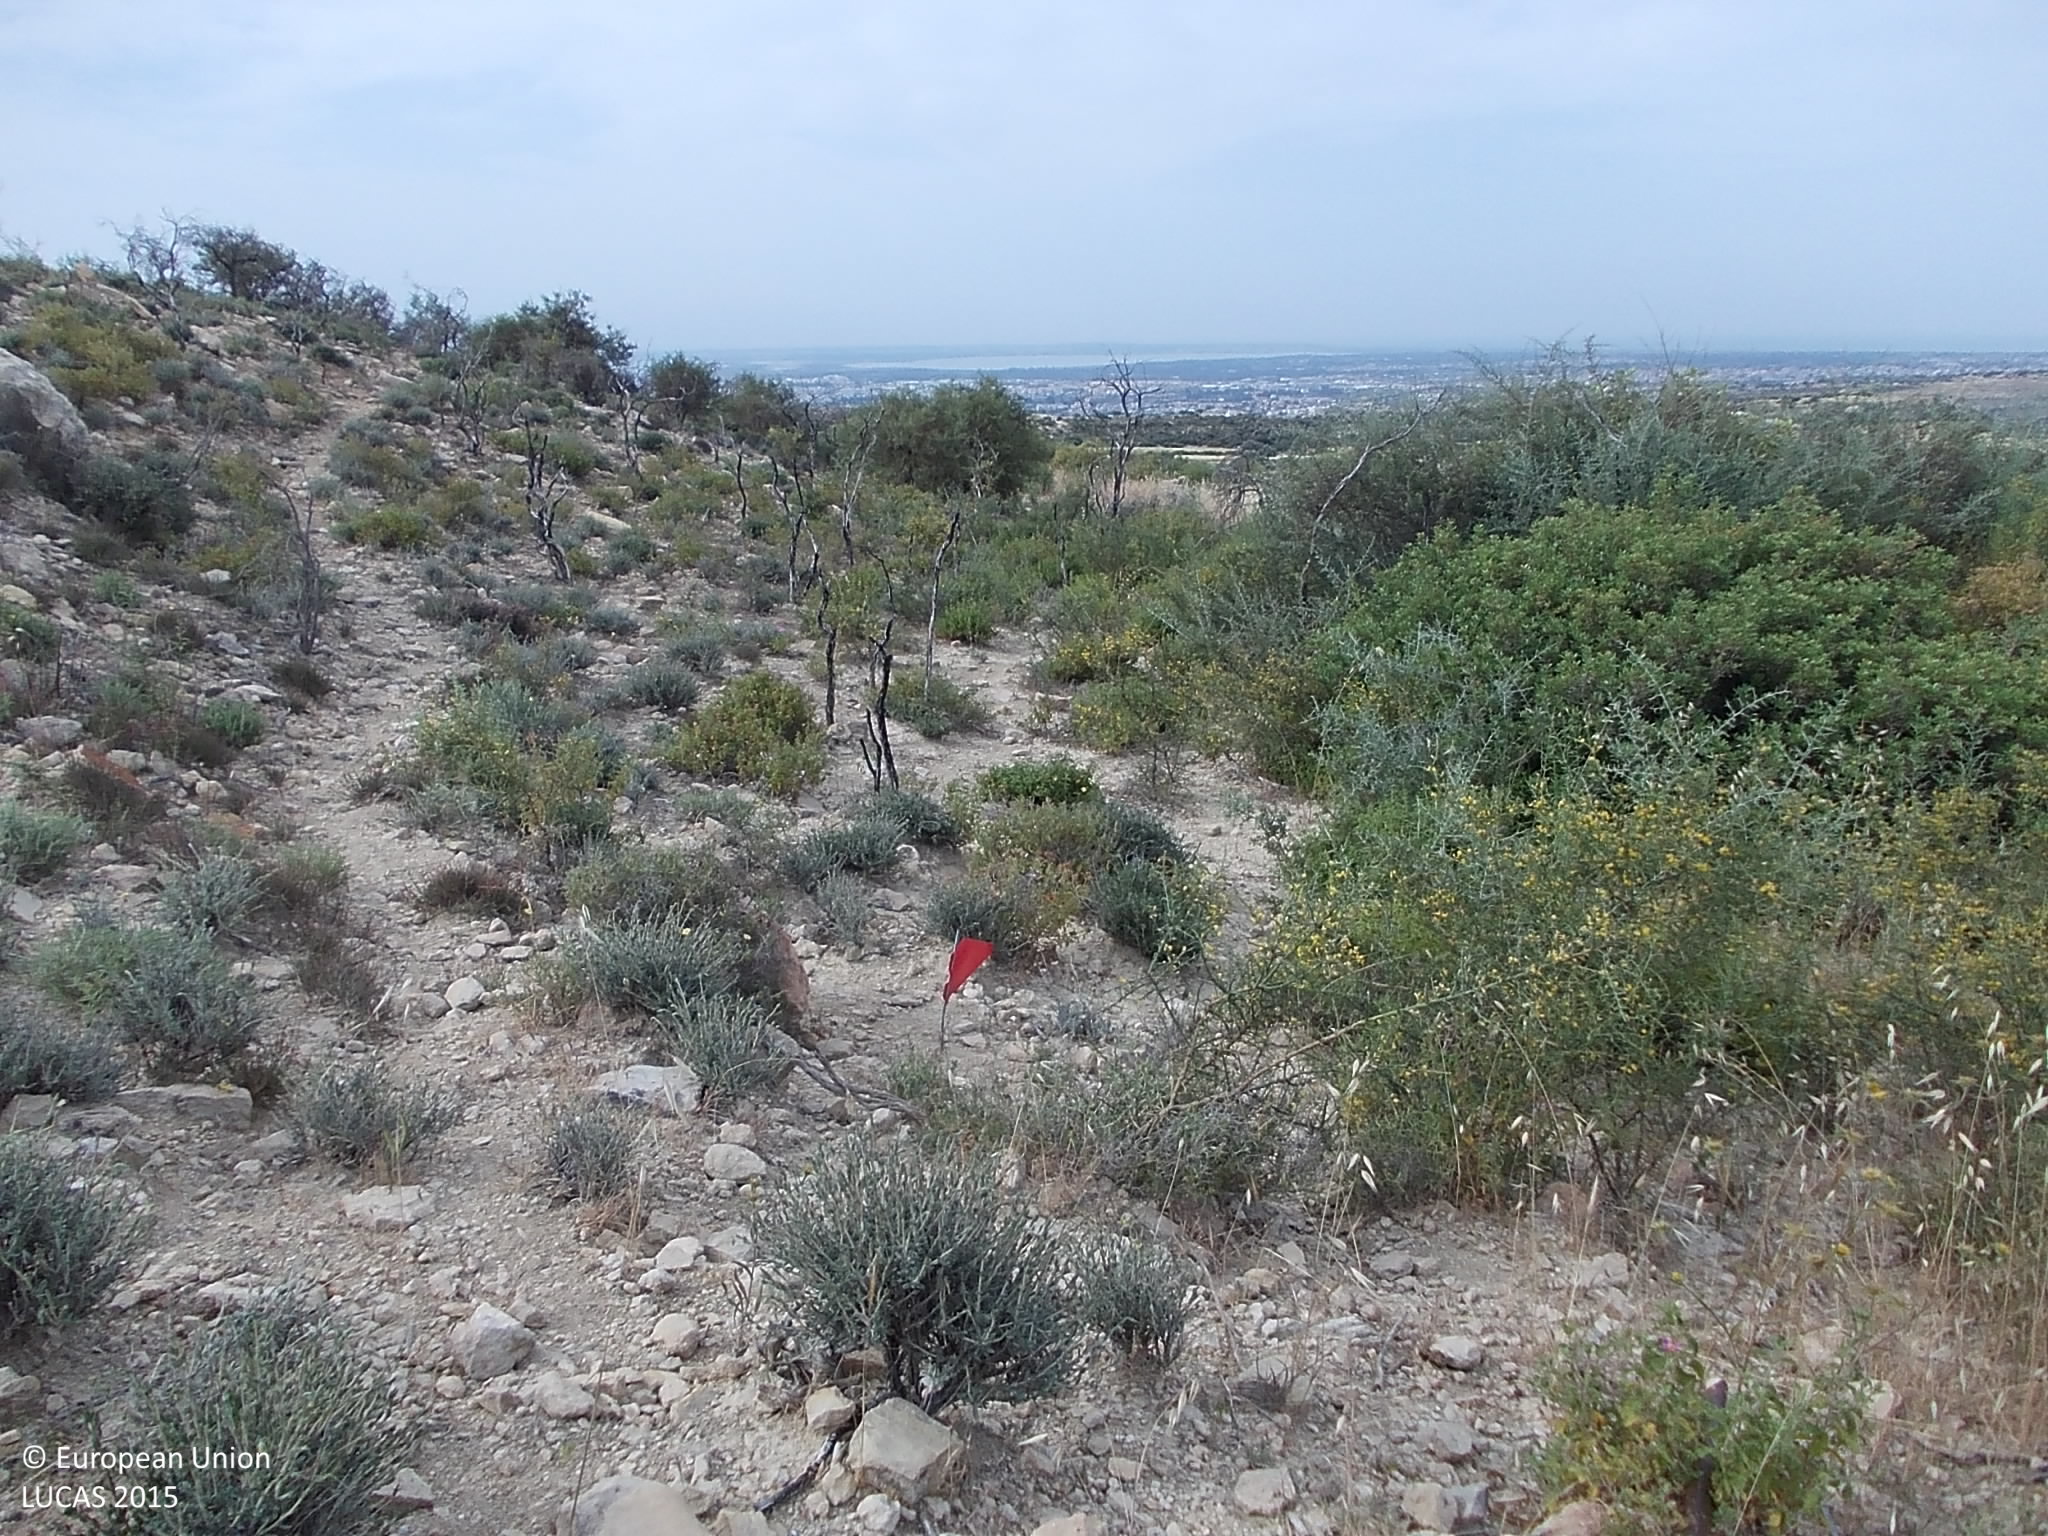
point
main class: Shrubland
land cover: Shrubland without tree cover
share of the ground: 25 - 50 %
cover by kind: shrubs 50 %, consolidated bare surface 20 %, unconsolidated bare surface 20 %, herbaceous plants 10 %
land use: Semi-natural and natural areas not in use
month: May
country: CY
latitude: 34.7370
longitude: 33.0029
